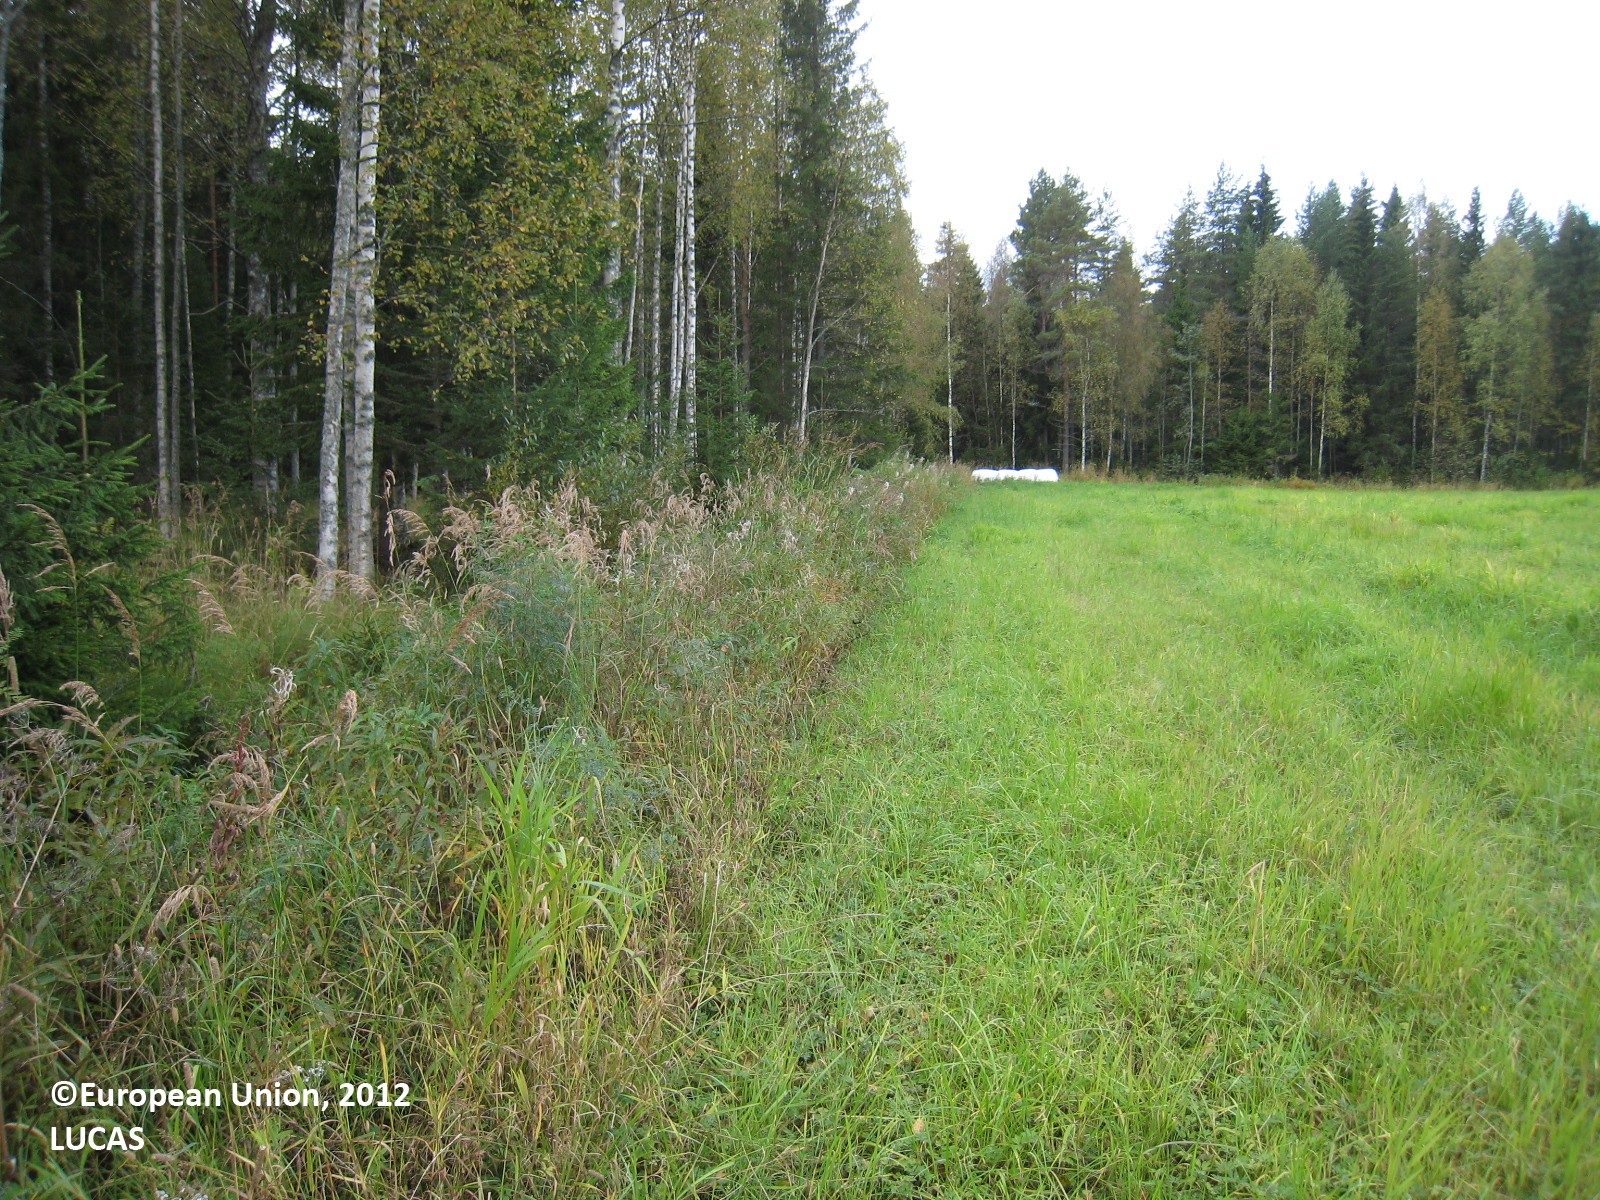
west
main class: Cropland
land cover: Temporary grasslands
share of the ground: > 75 %
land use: Agriculture (excluding fallow land and kitchen gardens)
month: September
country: FI
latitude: 63.2320
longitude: 26.4681
